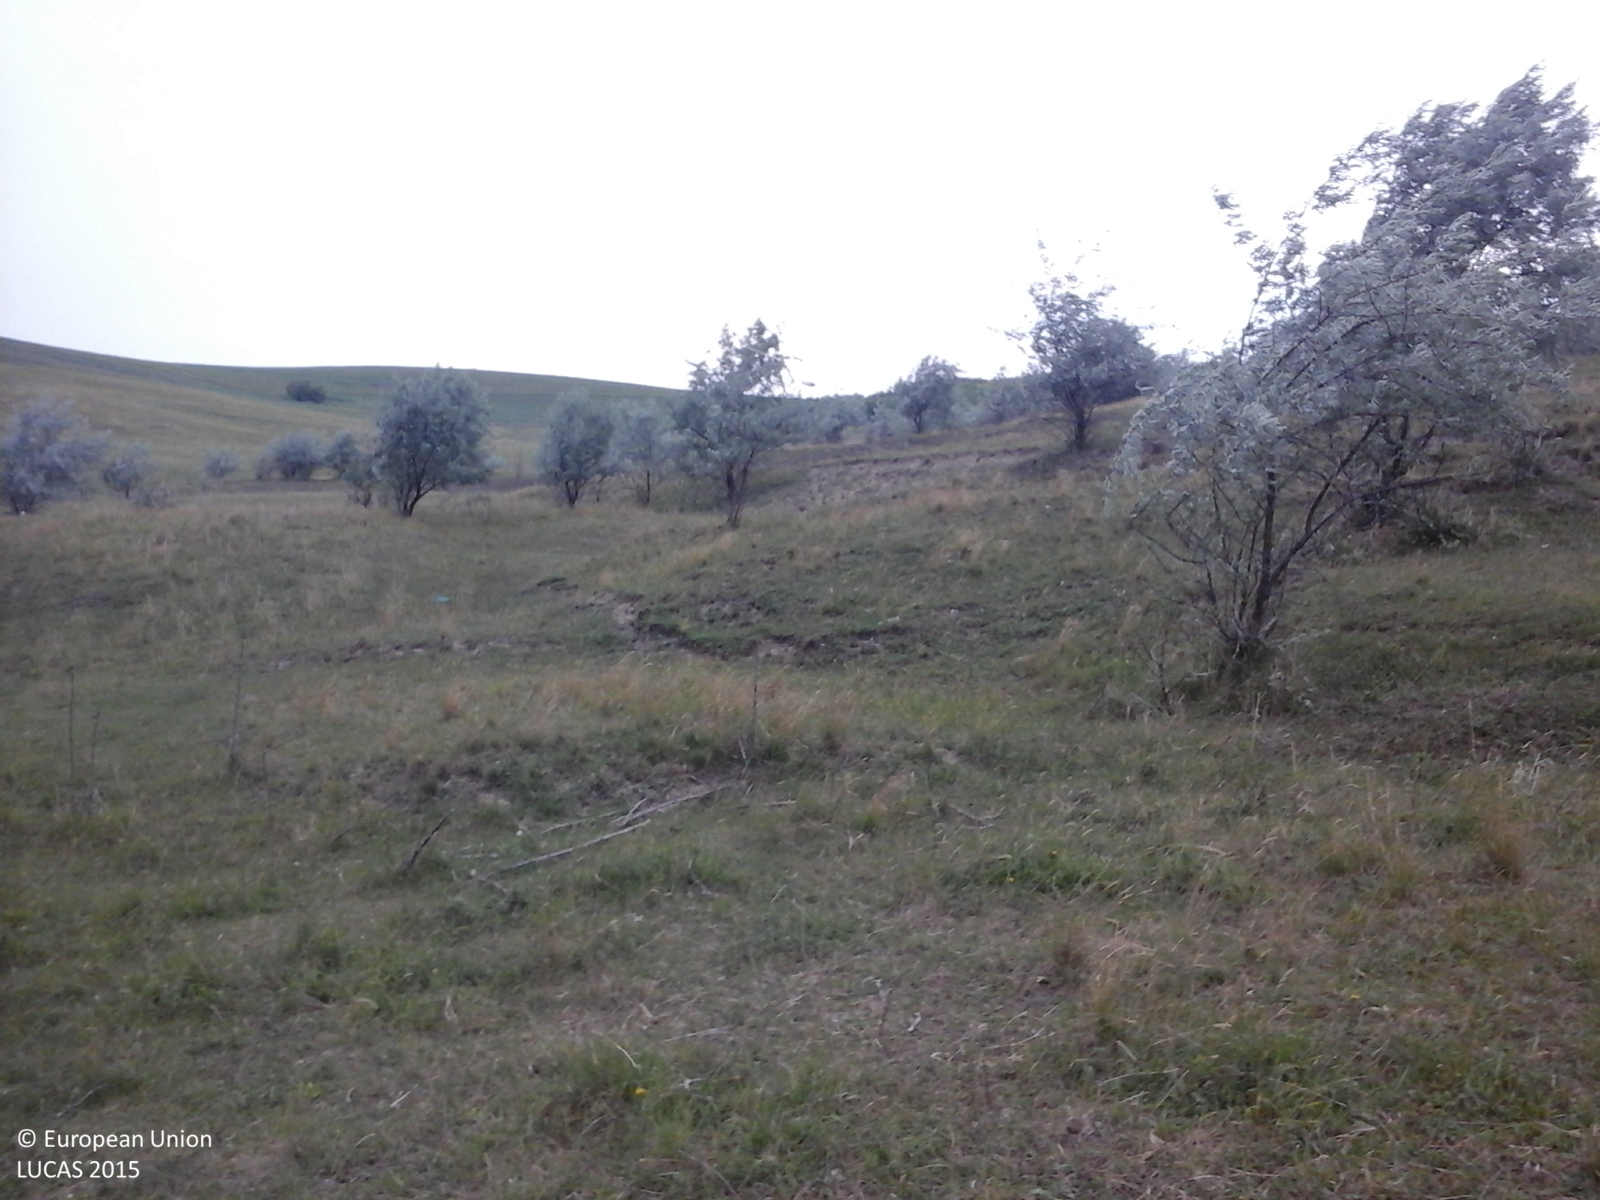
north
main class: Grassland
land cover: Grassland with sparse tree/shrub cover
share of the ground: > 75 %
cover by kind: herbaceous plants 85 %, shrubs 10 %, broadleaved forest trees 5 %
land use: Agriculture (excluding fallow land and kitchen gardens)
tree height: < 5 m
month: June
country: RO
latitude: 47.8574
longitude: 26.5734
